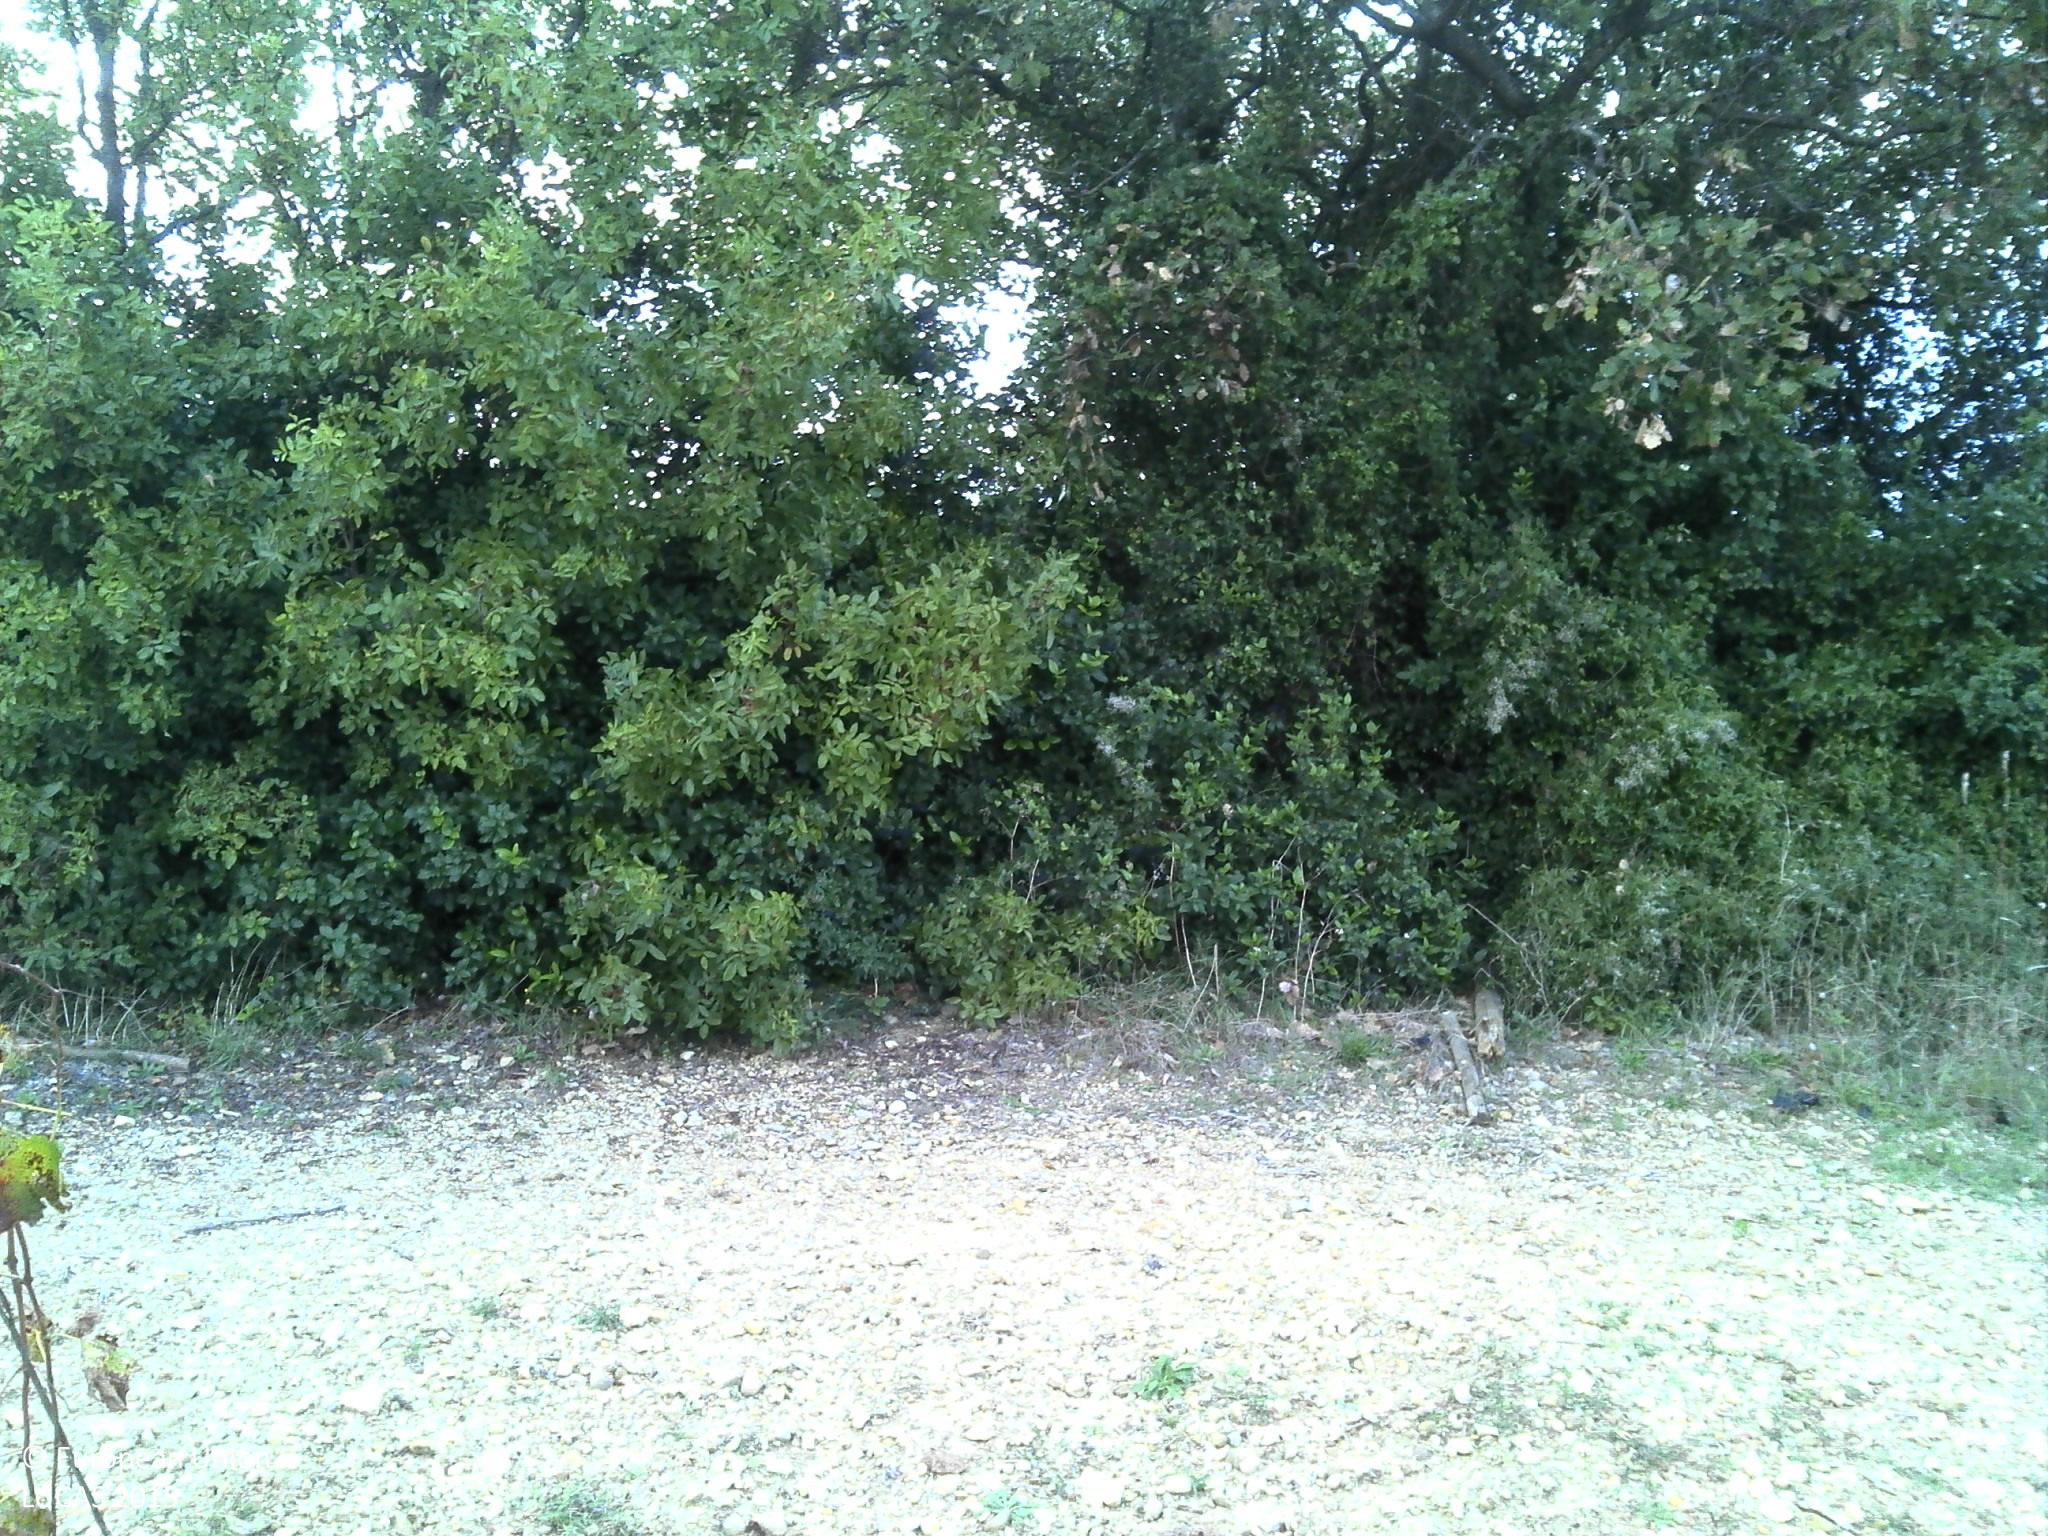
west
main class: Cropland
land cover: Vineyards
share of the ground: 10 - 25 %
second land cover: Other bare soil
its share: > 75 %
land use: Agriculture (excluding fallow land and kitchen gardens)
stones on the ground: 25 - 50 %
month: October
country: FR
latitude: 43.7421
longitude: 3.9865
